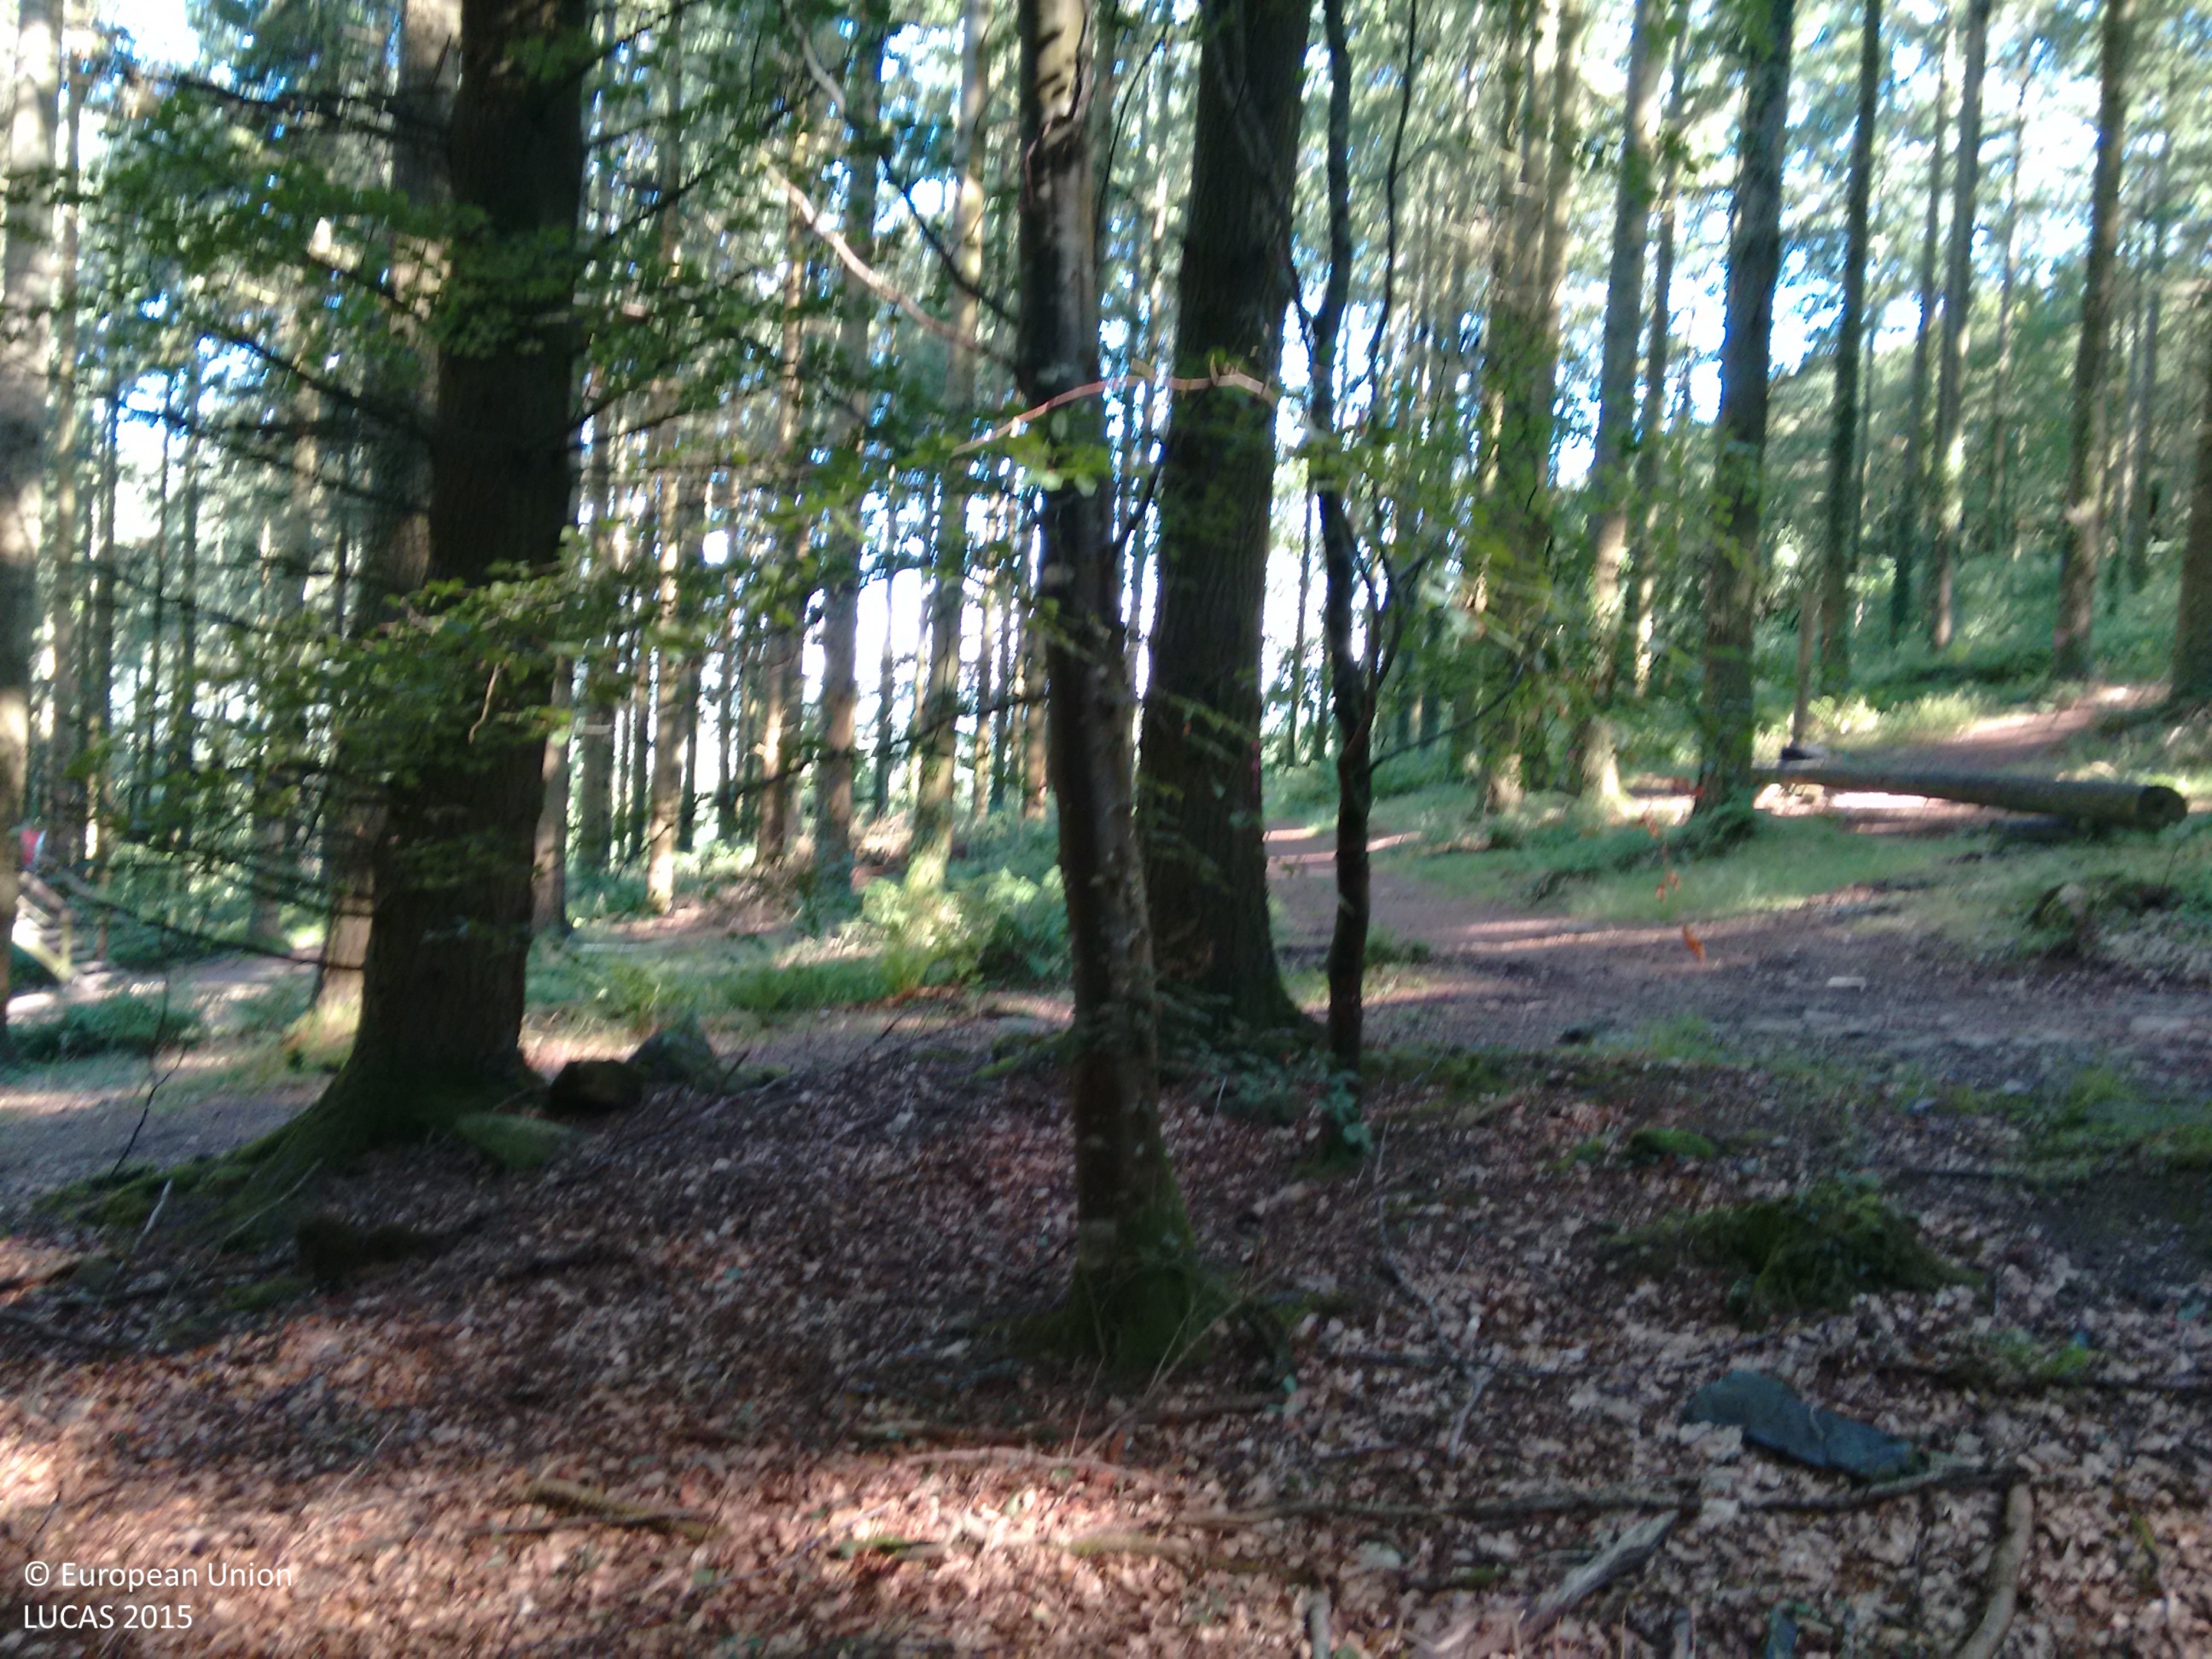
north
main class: Woodland
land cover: Broadleaved woodland
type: mesophytic deciduous forest
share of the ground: > 75 %
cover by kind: broadleaved forest trees 100 %
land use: Amenities, museums, leisure
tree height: > 5 m
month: August
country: GB
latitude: 53.1012
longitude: -3.7856
